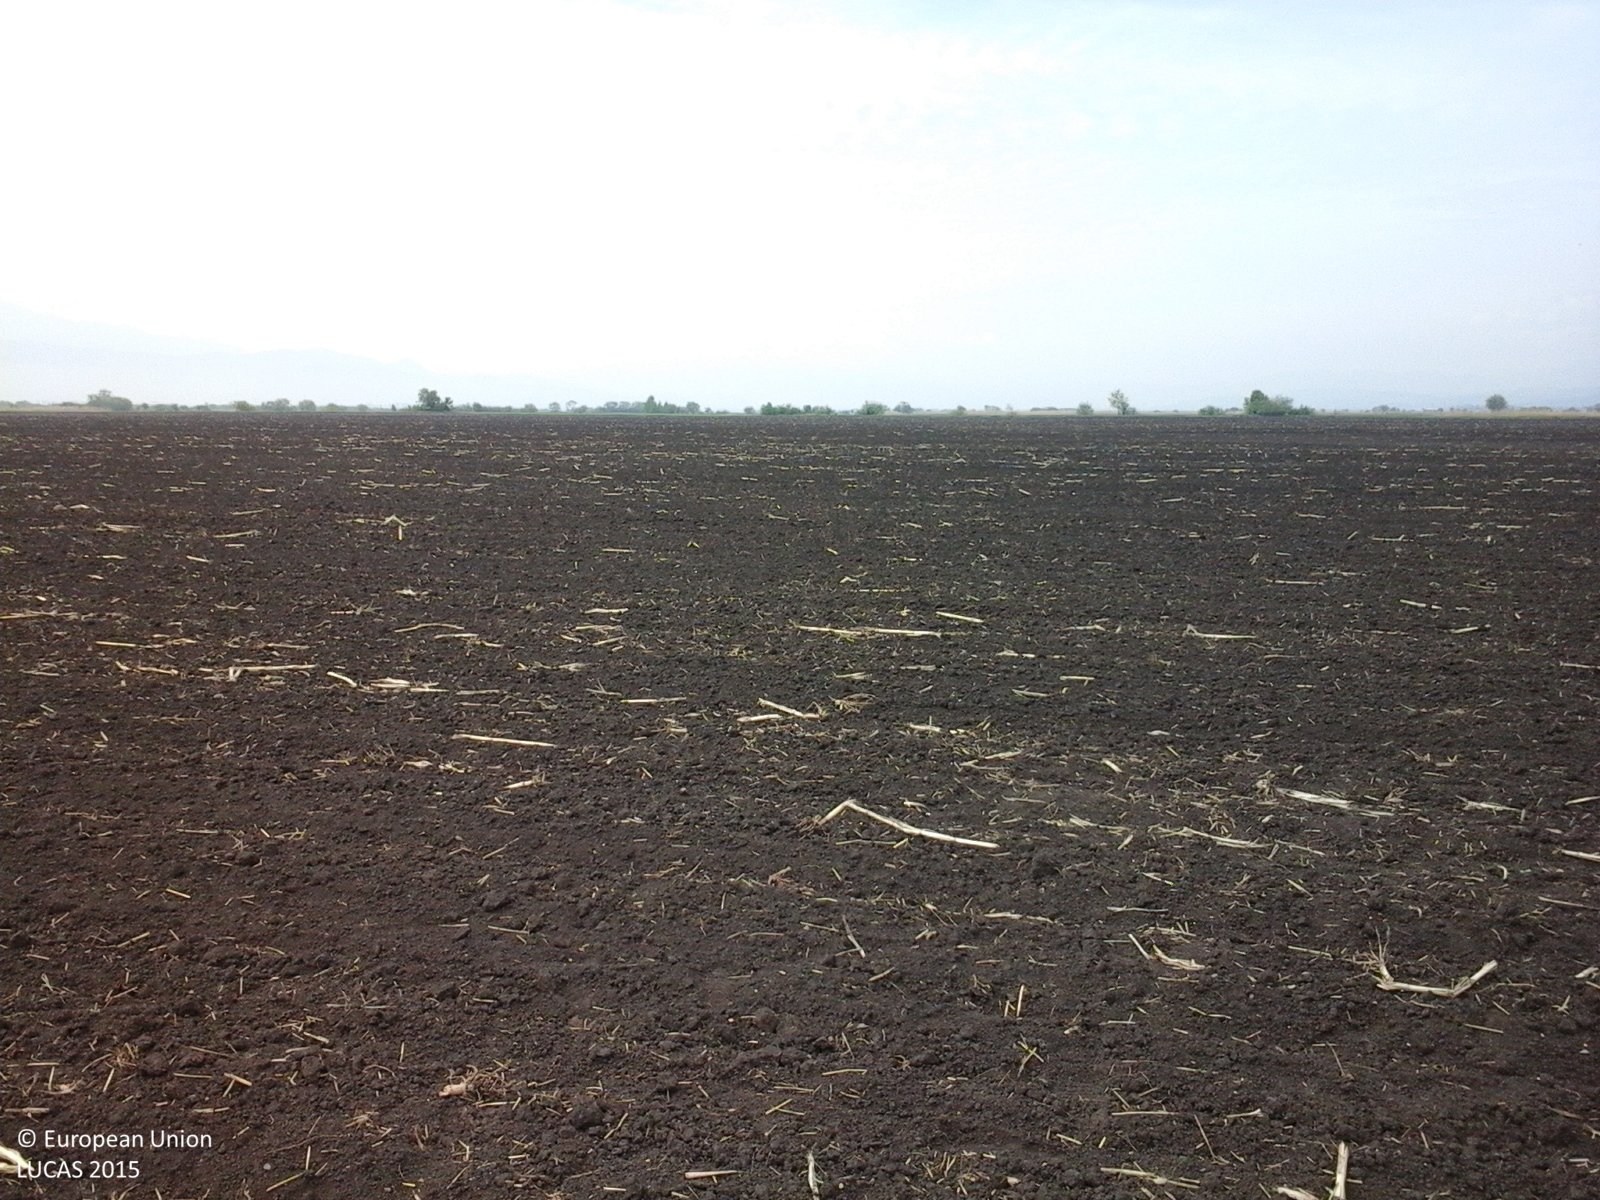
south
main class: Cropland
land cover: Maize
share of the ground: < 10 %
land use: Agriculture (excluding fallow land and kitchen gardens)
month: May
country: RO
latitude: 45.7246
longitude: 25.5087
